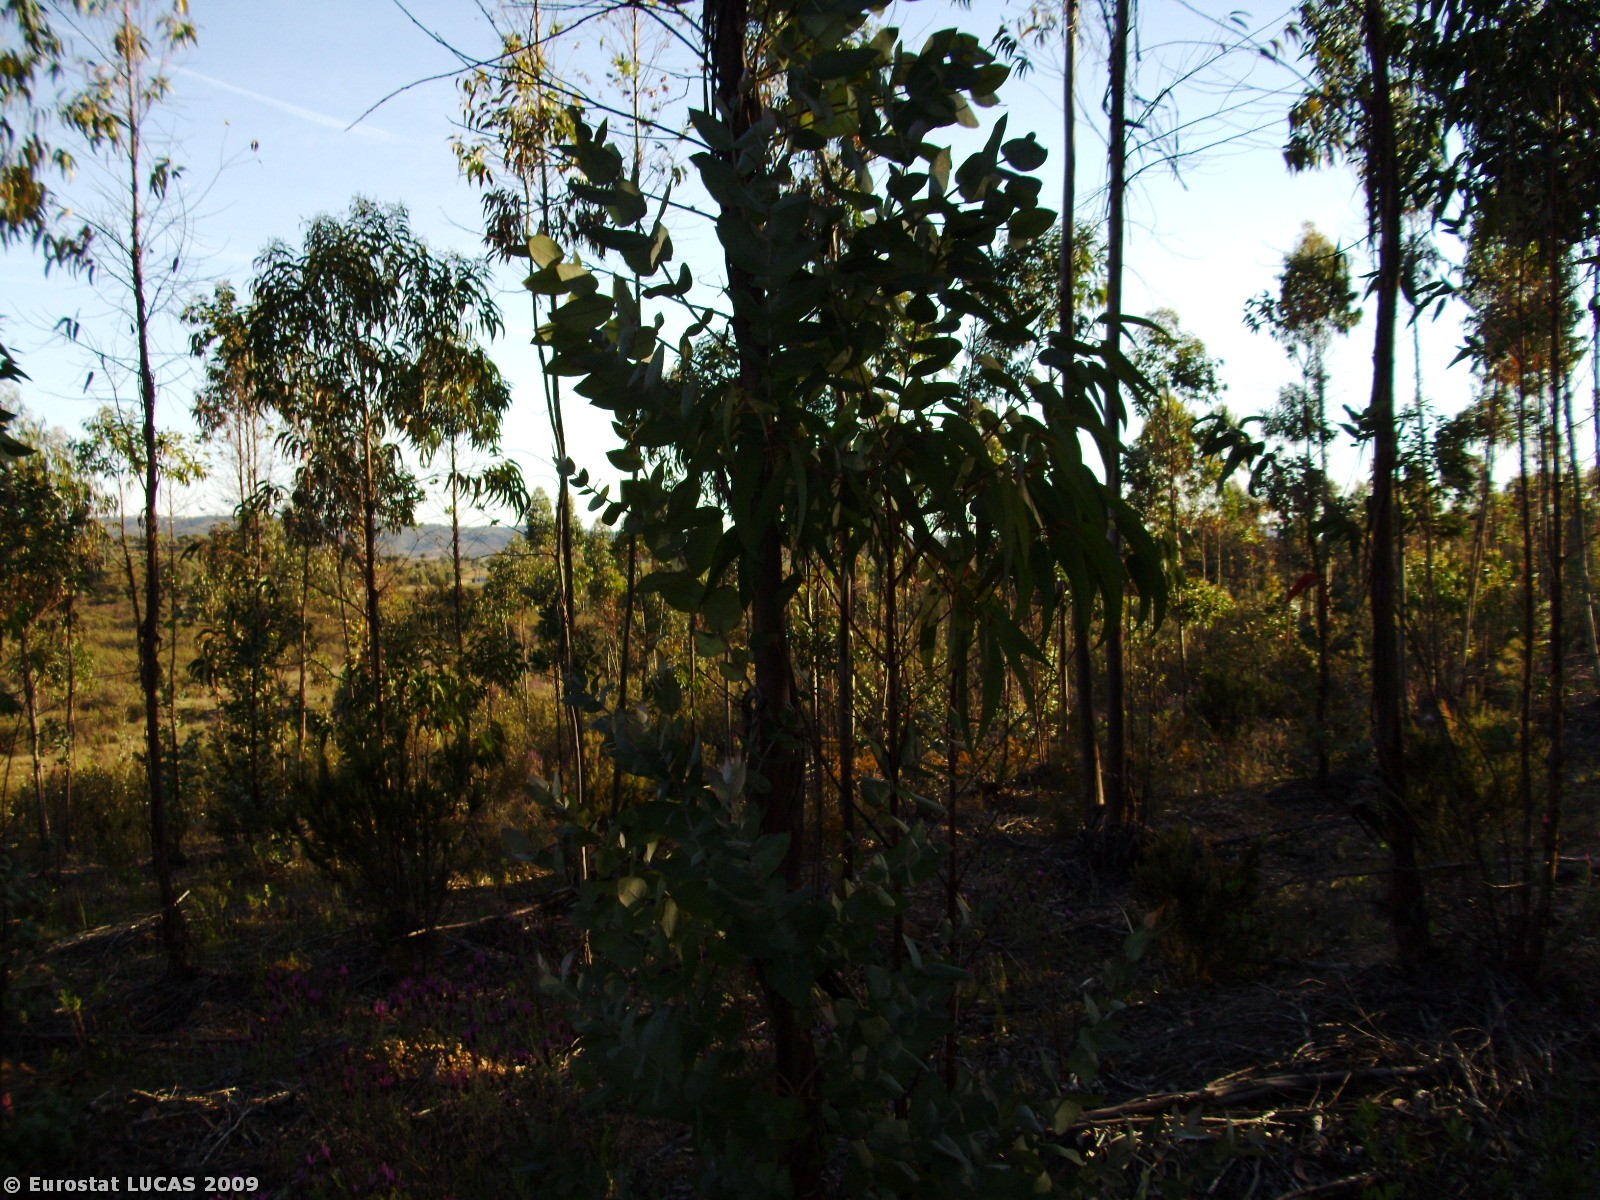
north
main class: Woodland
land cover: Broadleaved woodland
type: plantations and self-sown exotic forest
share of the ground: > 75 %
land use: Forestry
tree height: > 5 m
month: May
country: PT
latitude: 39.6862
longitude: -7.5532
